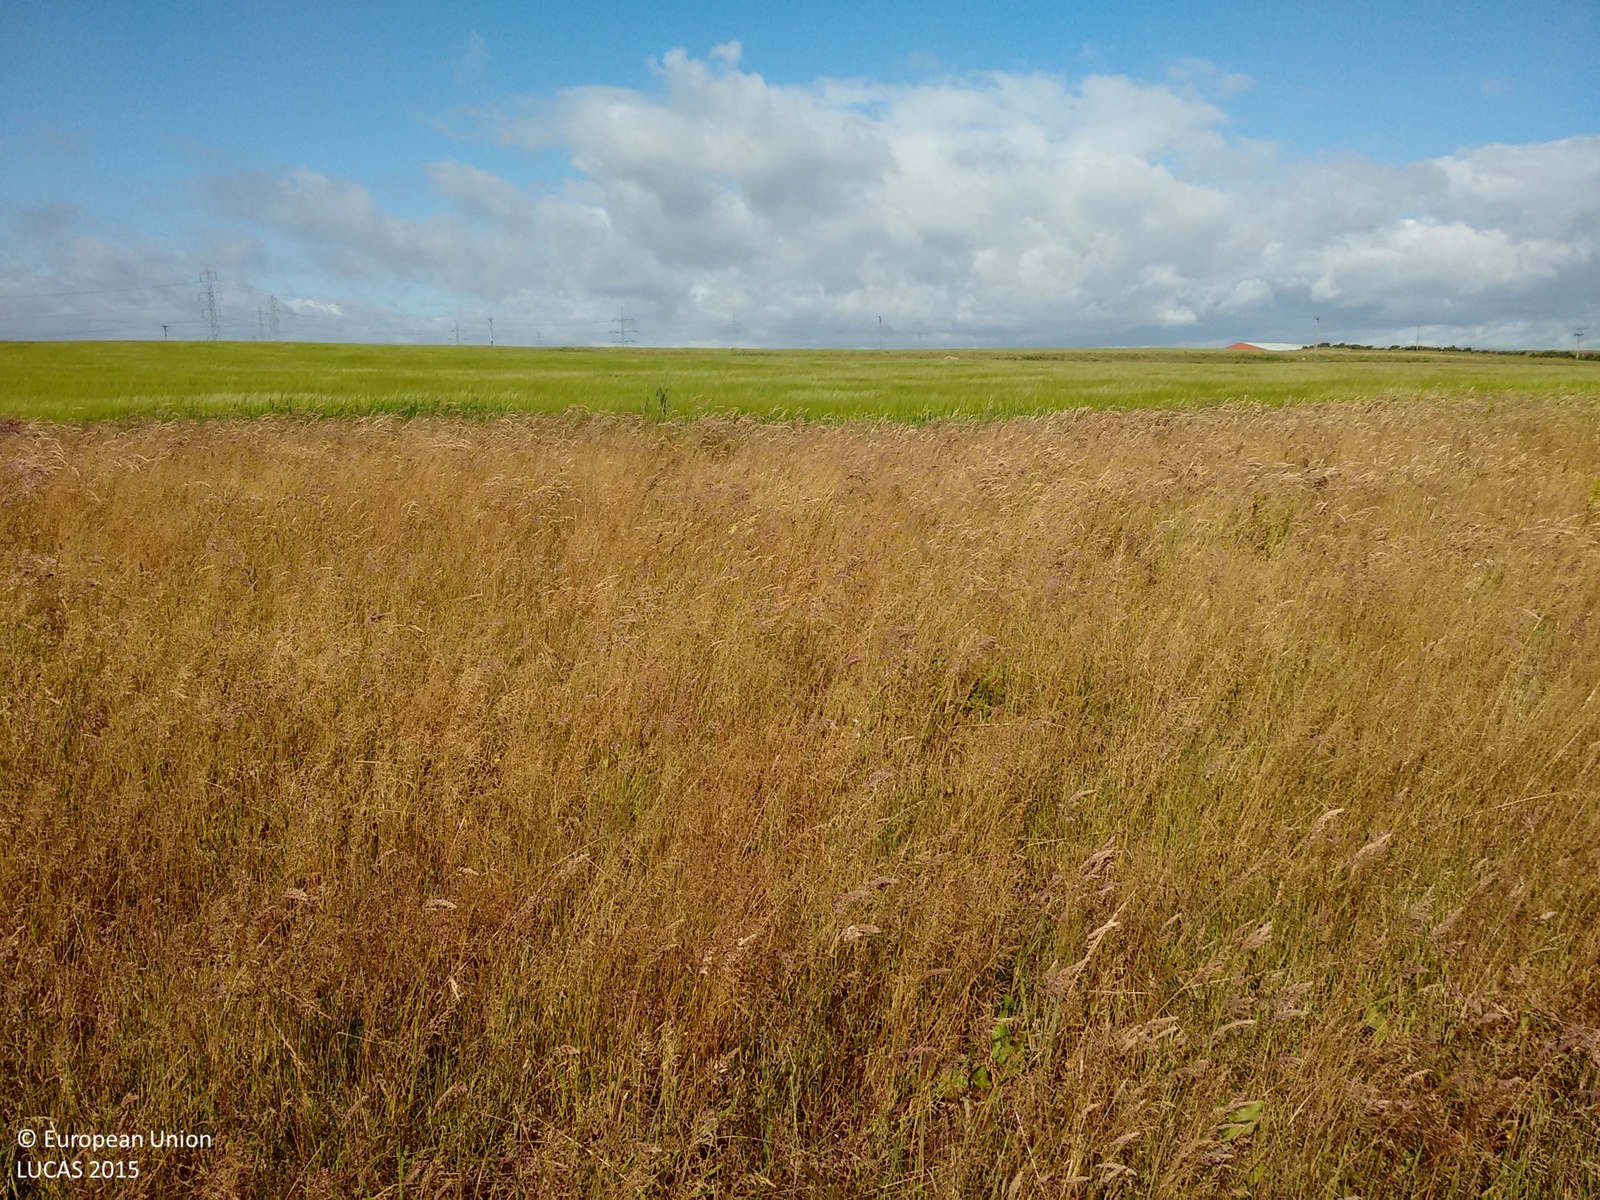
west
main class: Grassland
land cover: Grassland without tree/shrub cover
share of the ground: > 75 %
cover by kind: herbaceous plants 100 %
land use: Agriculture (excluding fallow land and kitchen gardens)
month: July
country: GB
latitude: 57.4791
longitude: -1.8000
